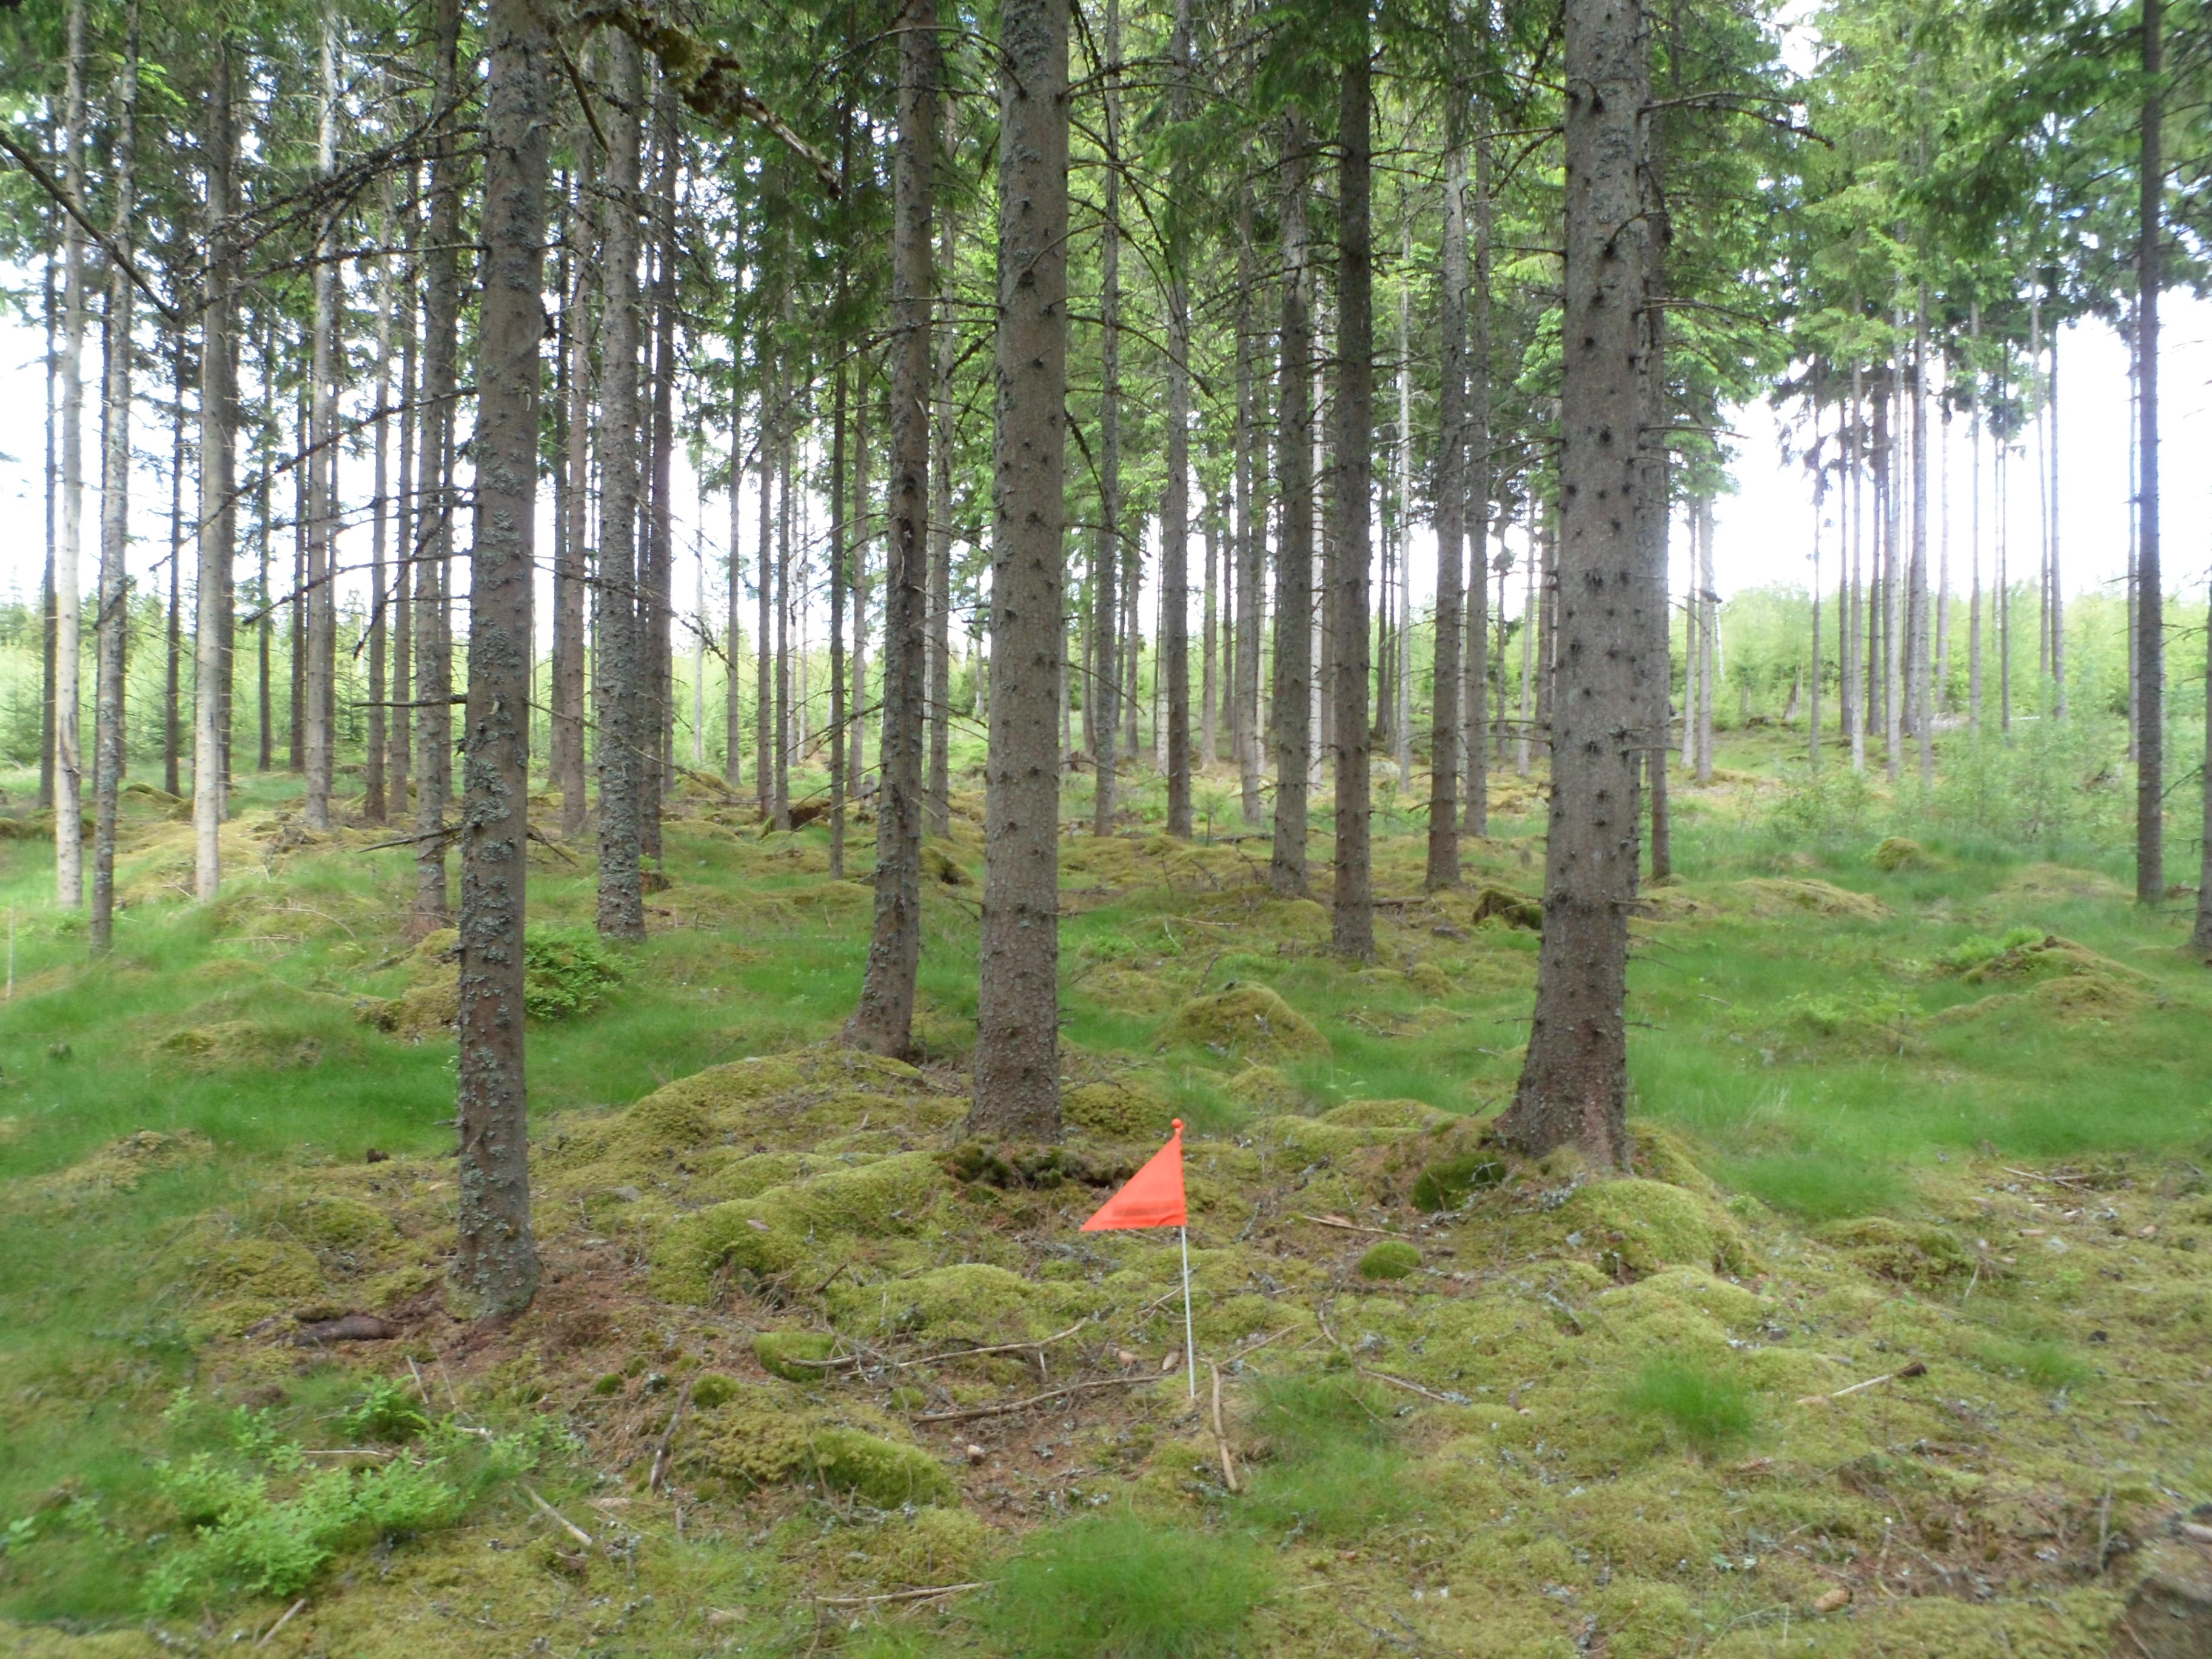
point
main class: Woodland
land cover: Spruce dominated coniferous woodland
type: boreal forest
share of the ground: 50 - 75 %
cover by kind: coniferous forest trees 60 %, herbaceous plants 15 %, lichens and mosses 15 %, shrubs 10 %
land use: Forestry
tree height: > 5 m
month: June
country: SE
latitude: 57.3740
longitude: 14.3695
